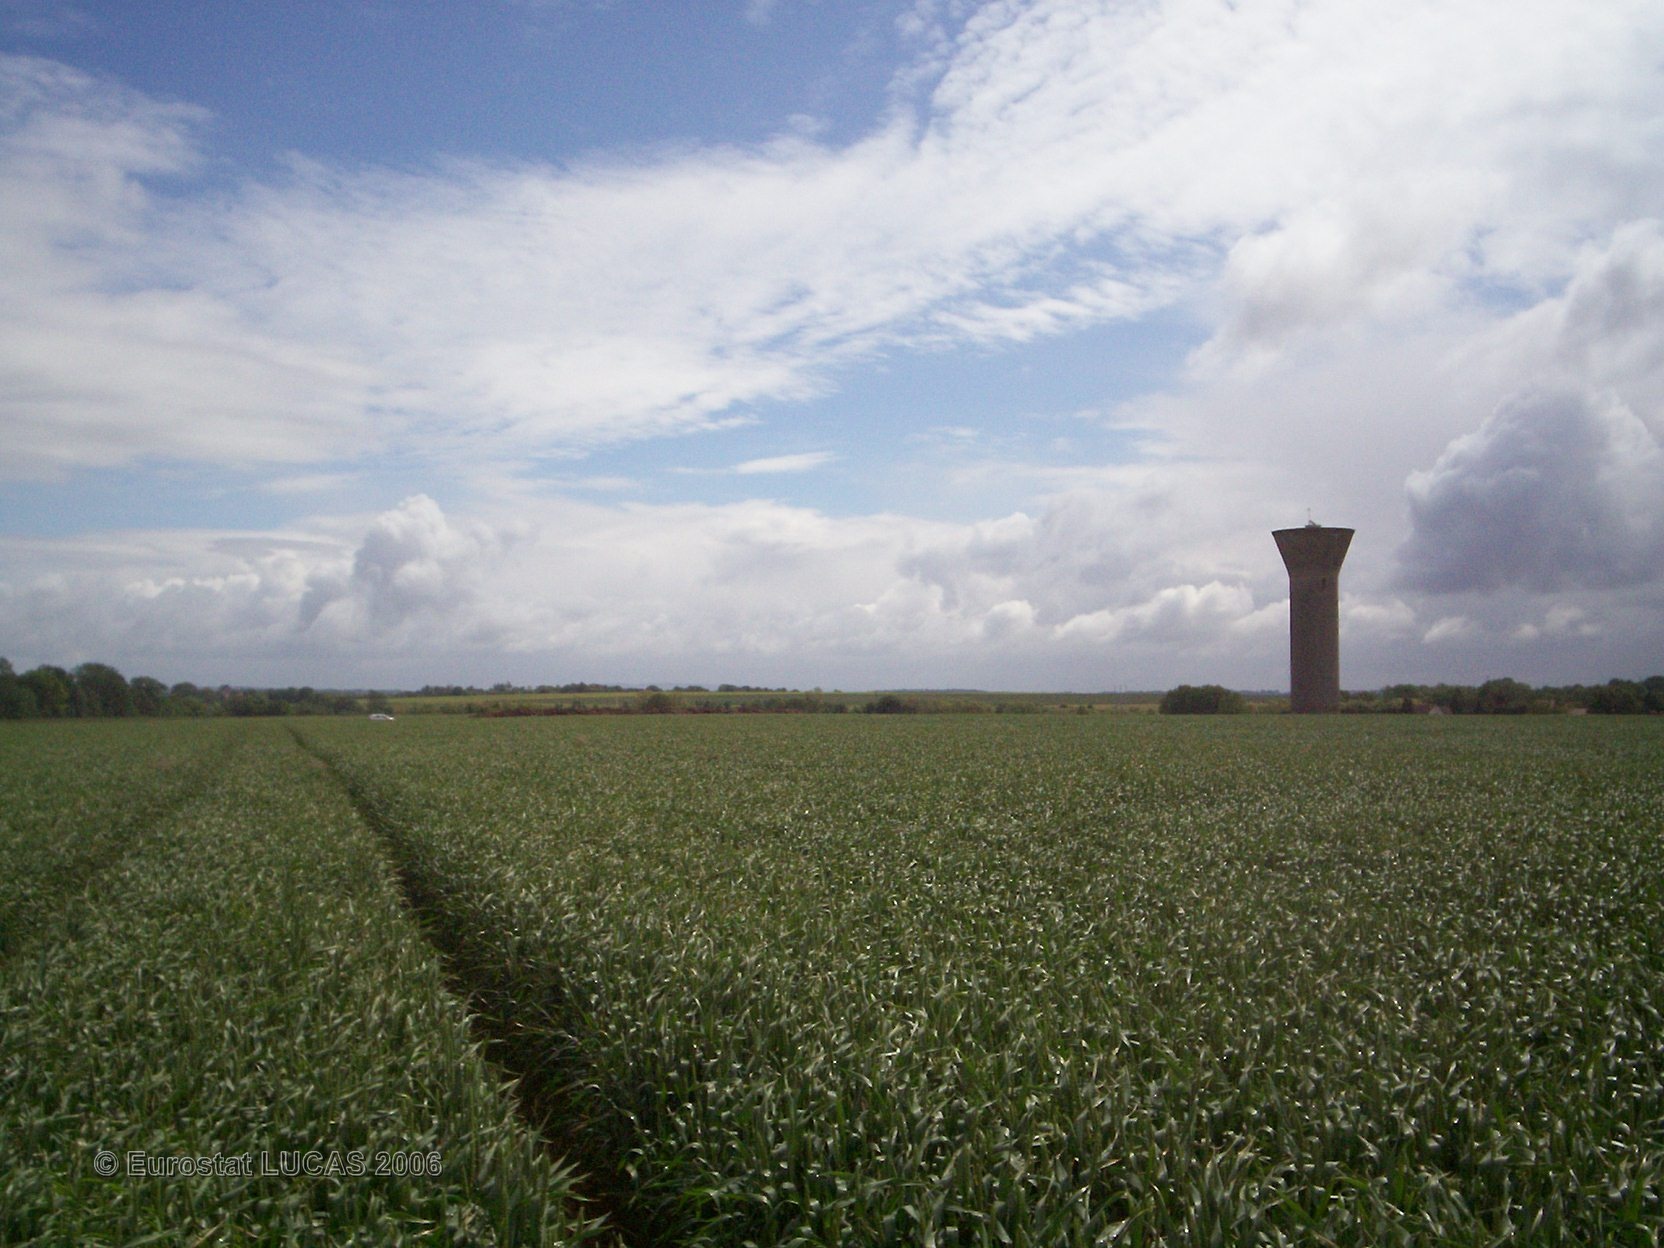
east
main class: Cropland
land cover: Common wheat
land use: Agriculture (excluding fallow land and kitchen gardens)
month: May
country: FR
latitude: 49.2866
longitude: 2.7719
